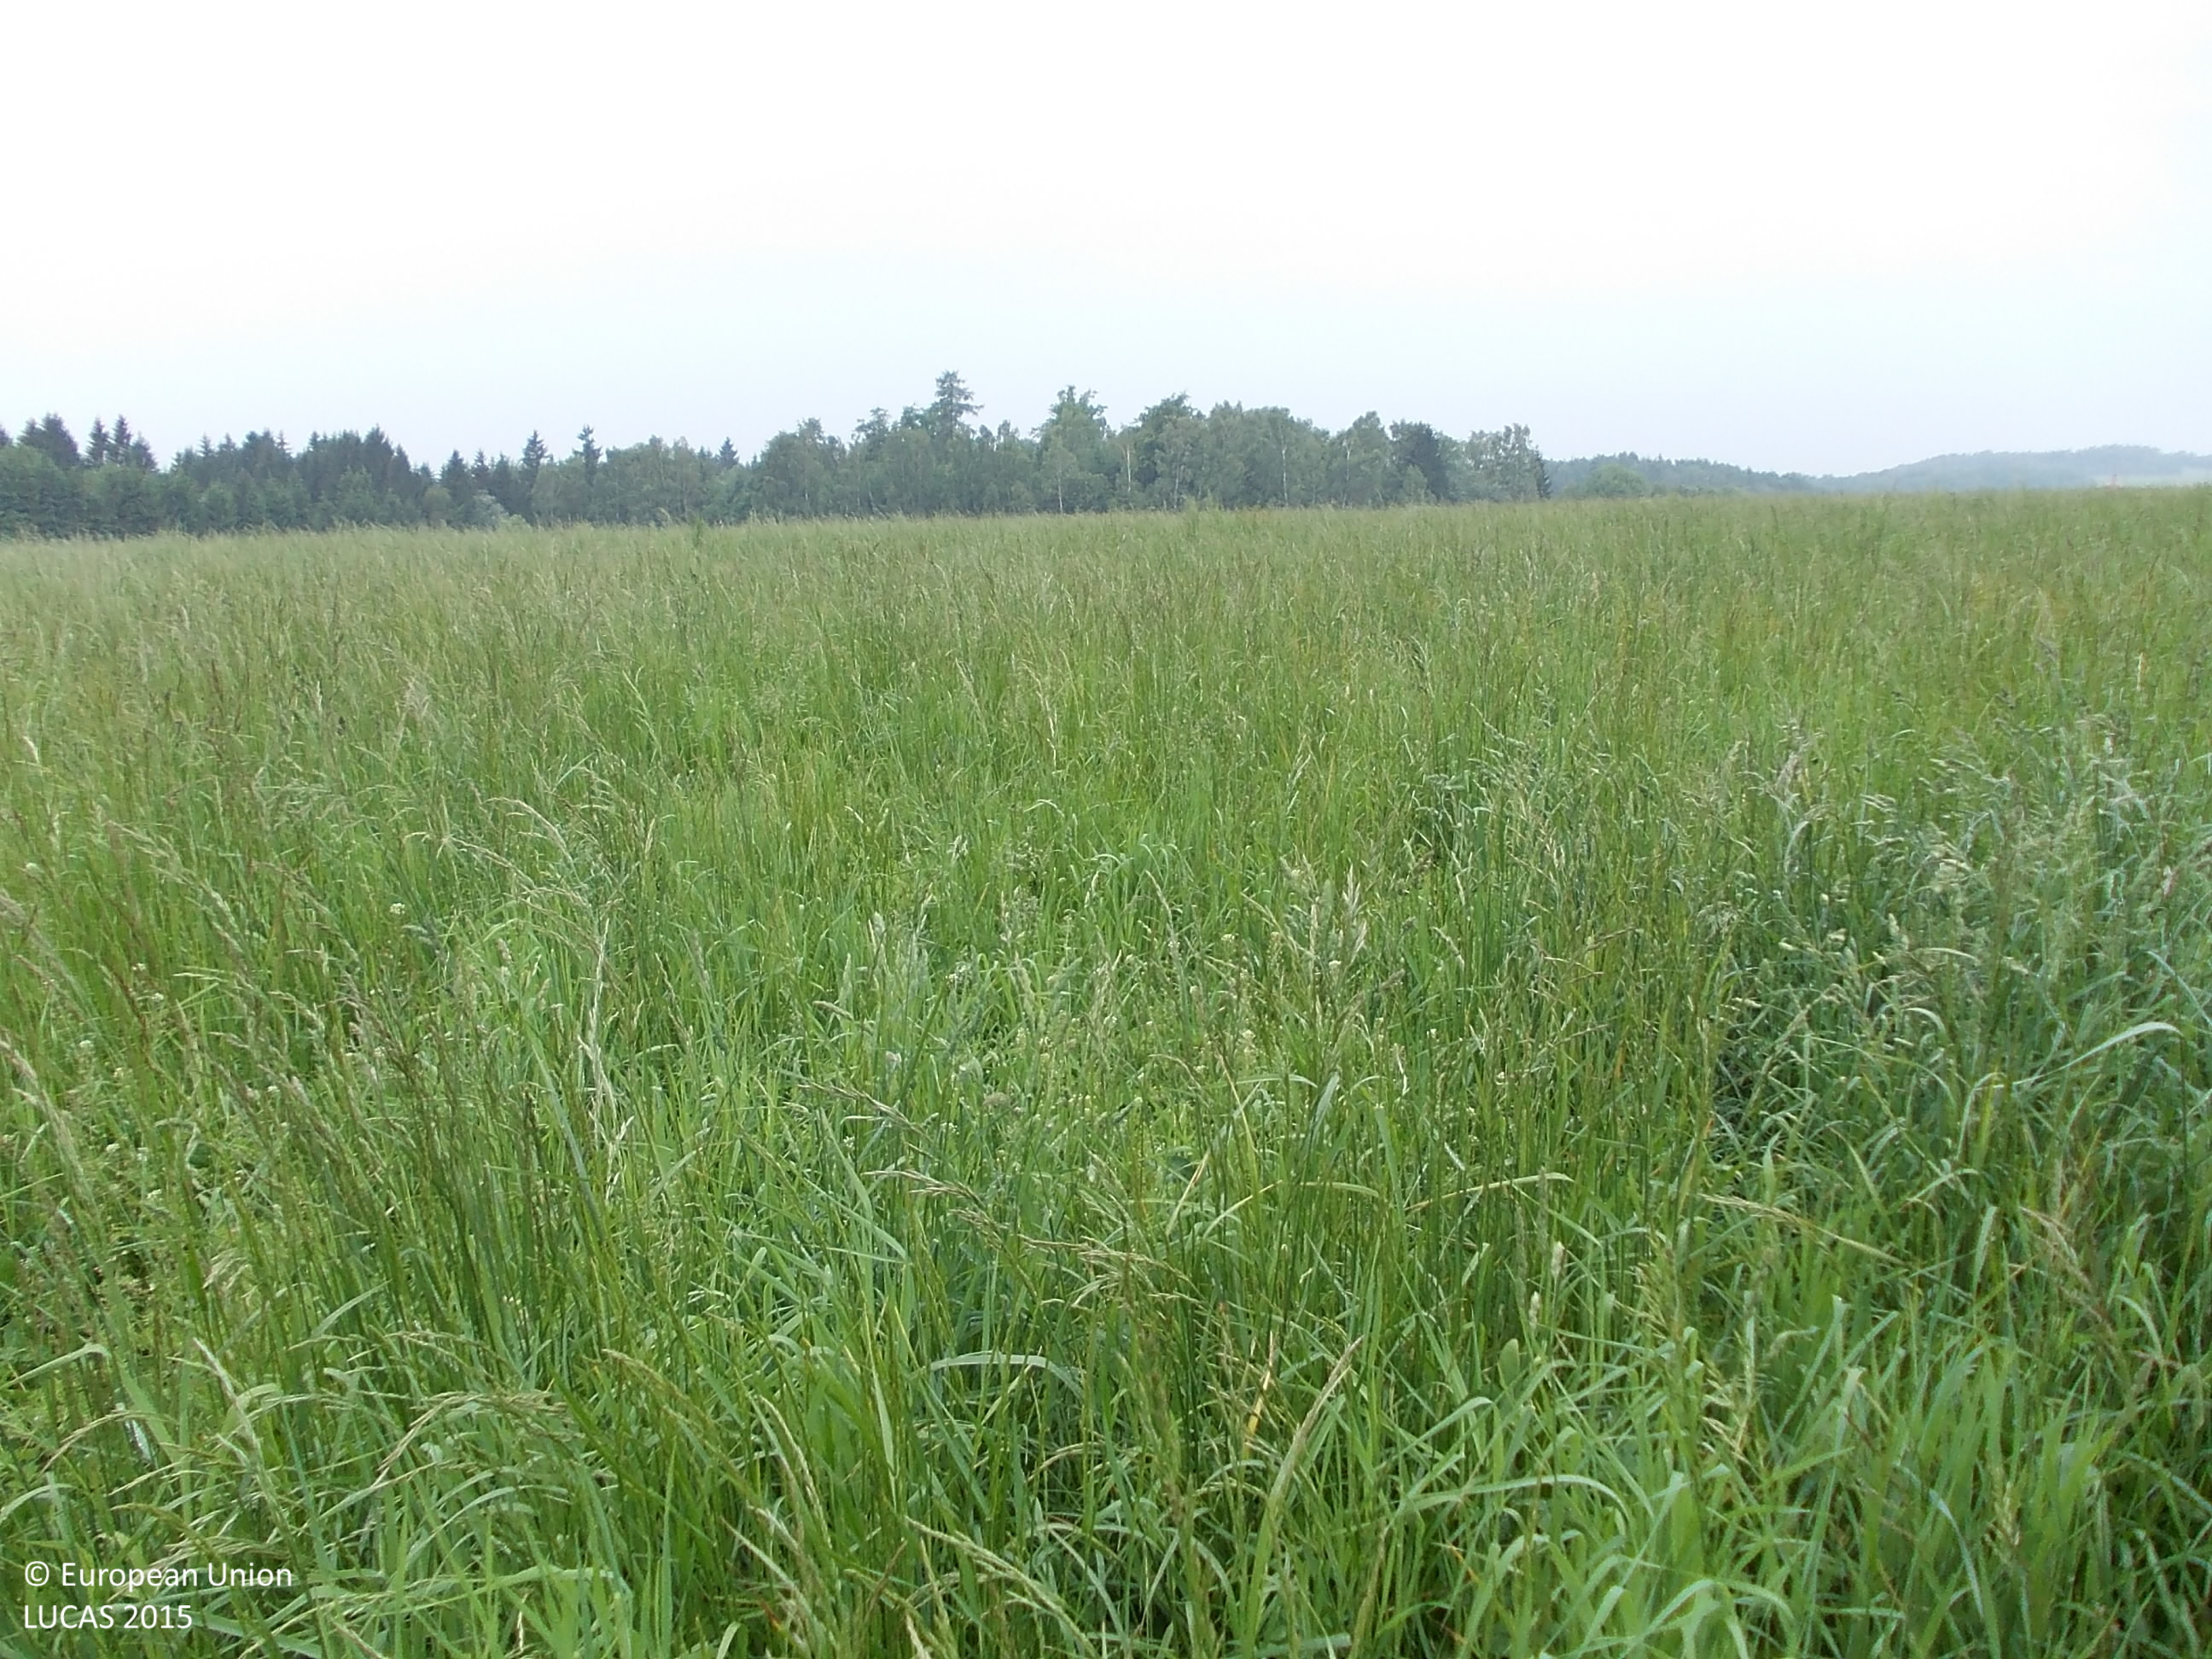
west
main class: Grassland
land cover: Grassland without tree/shrub cover
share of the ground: > 75 %
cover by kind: herbaceous plants 100 %
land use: Agriculture (excluding fallow land and kitchen gardens)
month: June
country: CZ
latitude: 50.2412
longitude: 16.3588
